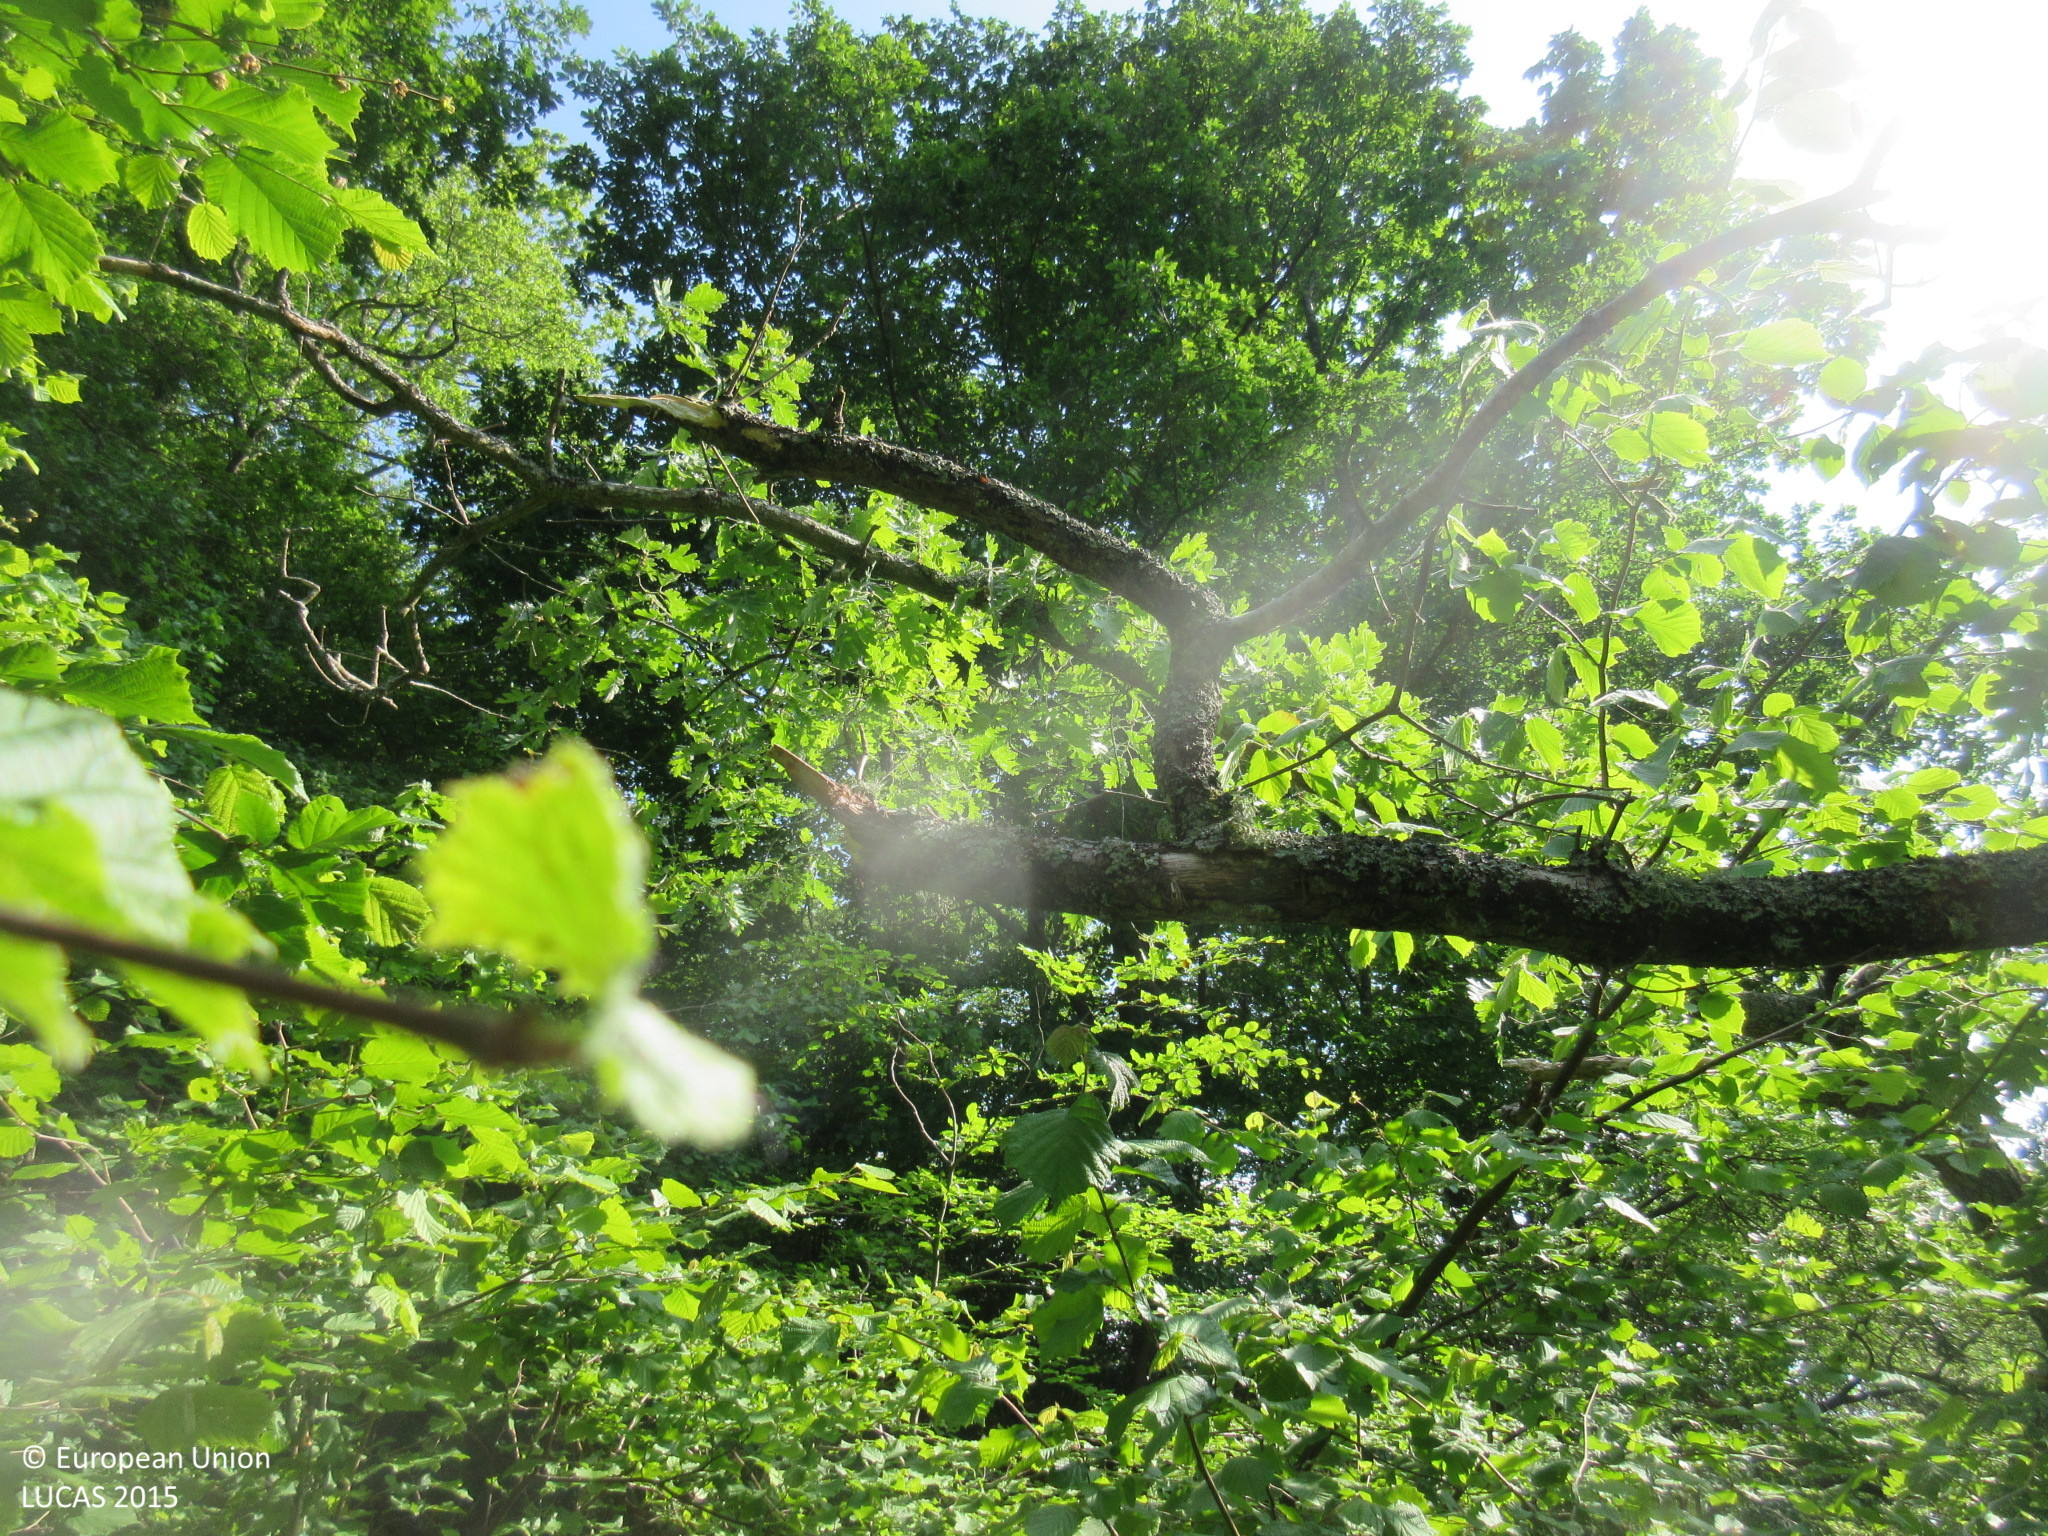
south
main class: Woodland
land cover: Broadleaved woodland
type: mesophytic deciduous forest
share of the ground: > 75 %
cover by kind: broadleaved forest trees 100 %
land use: Semi-natural and natural areas not in use
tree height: > 5 m
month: May
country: ES
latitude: 43.1881
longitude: -4.5665
